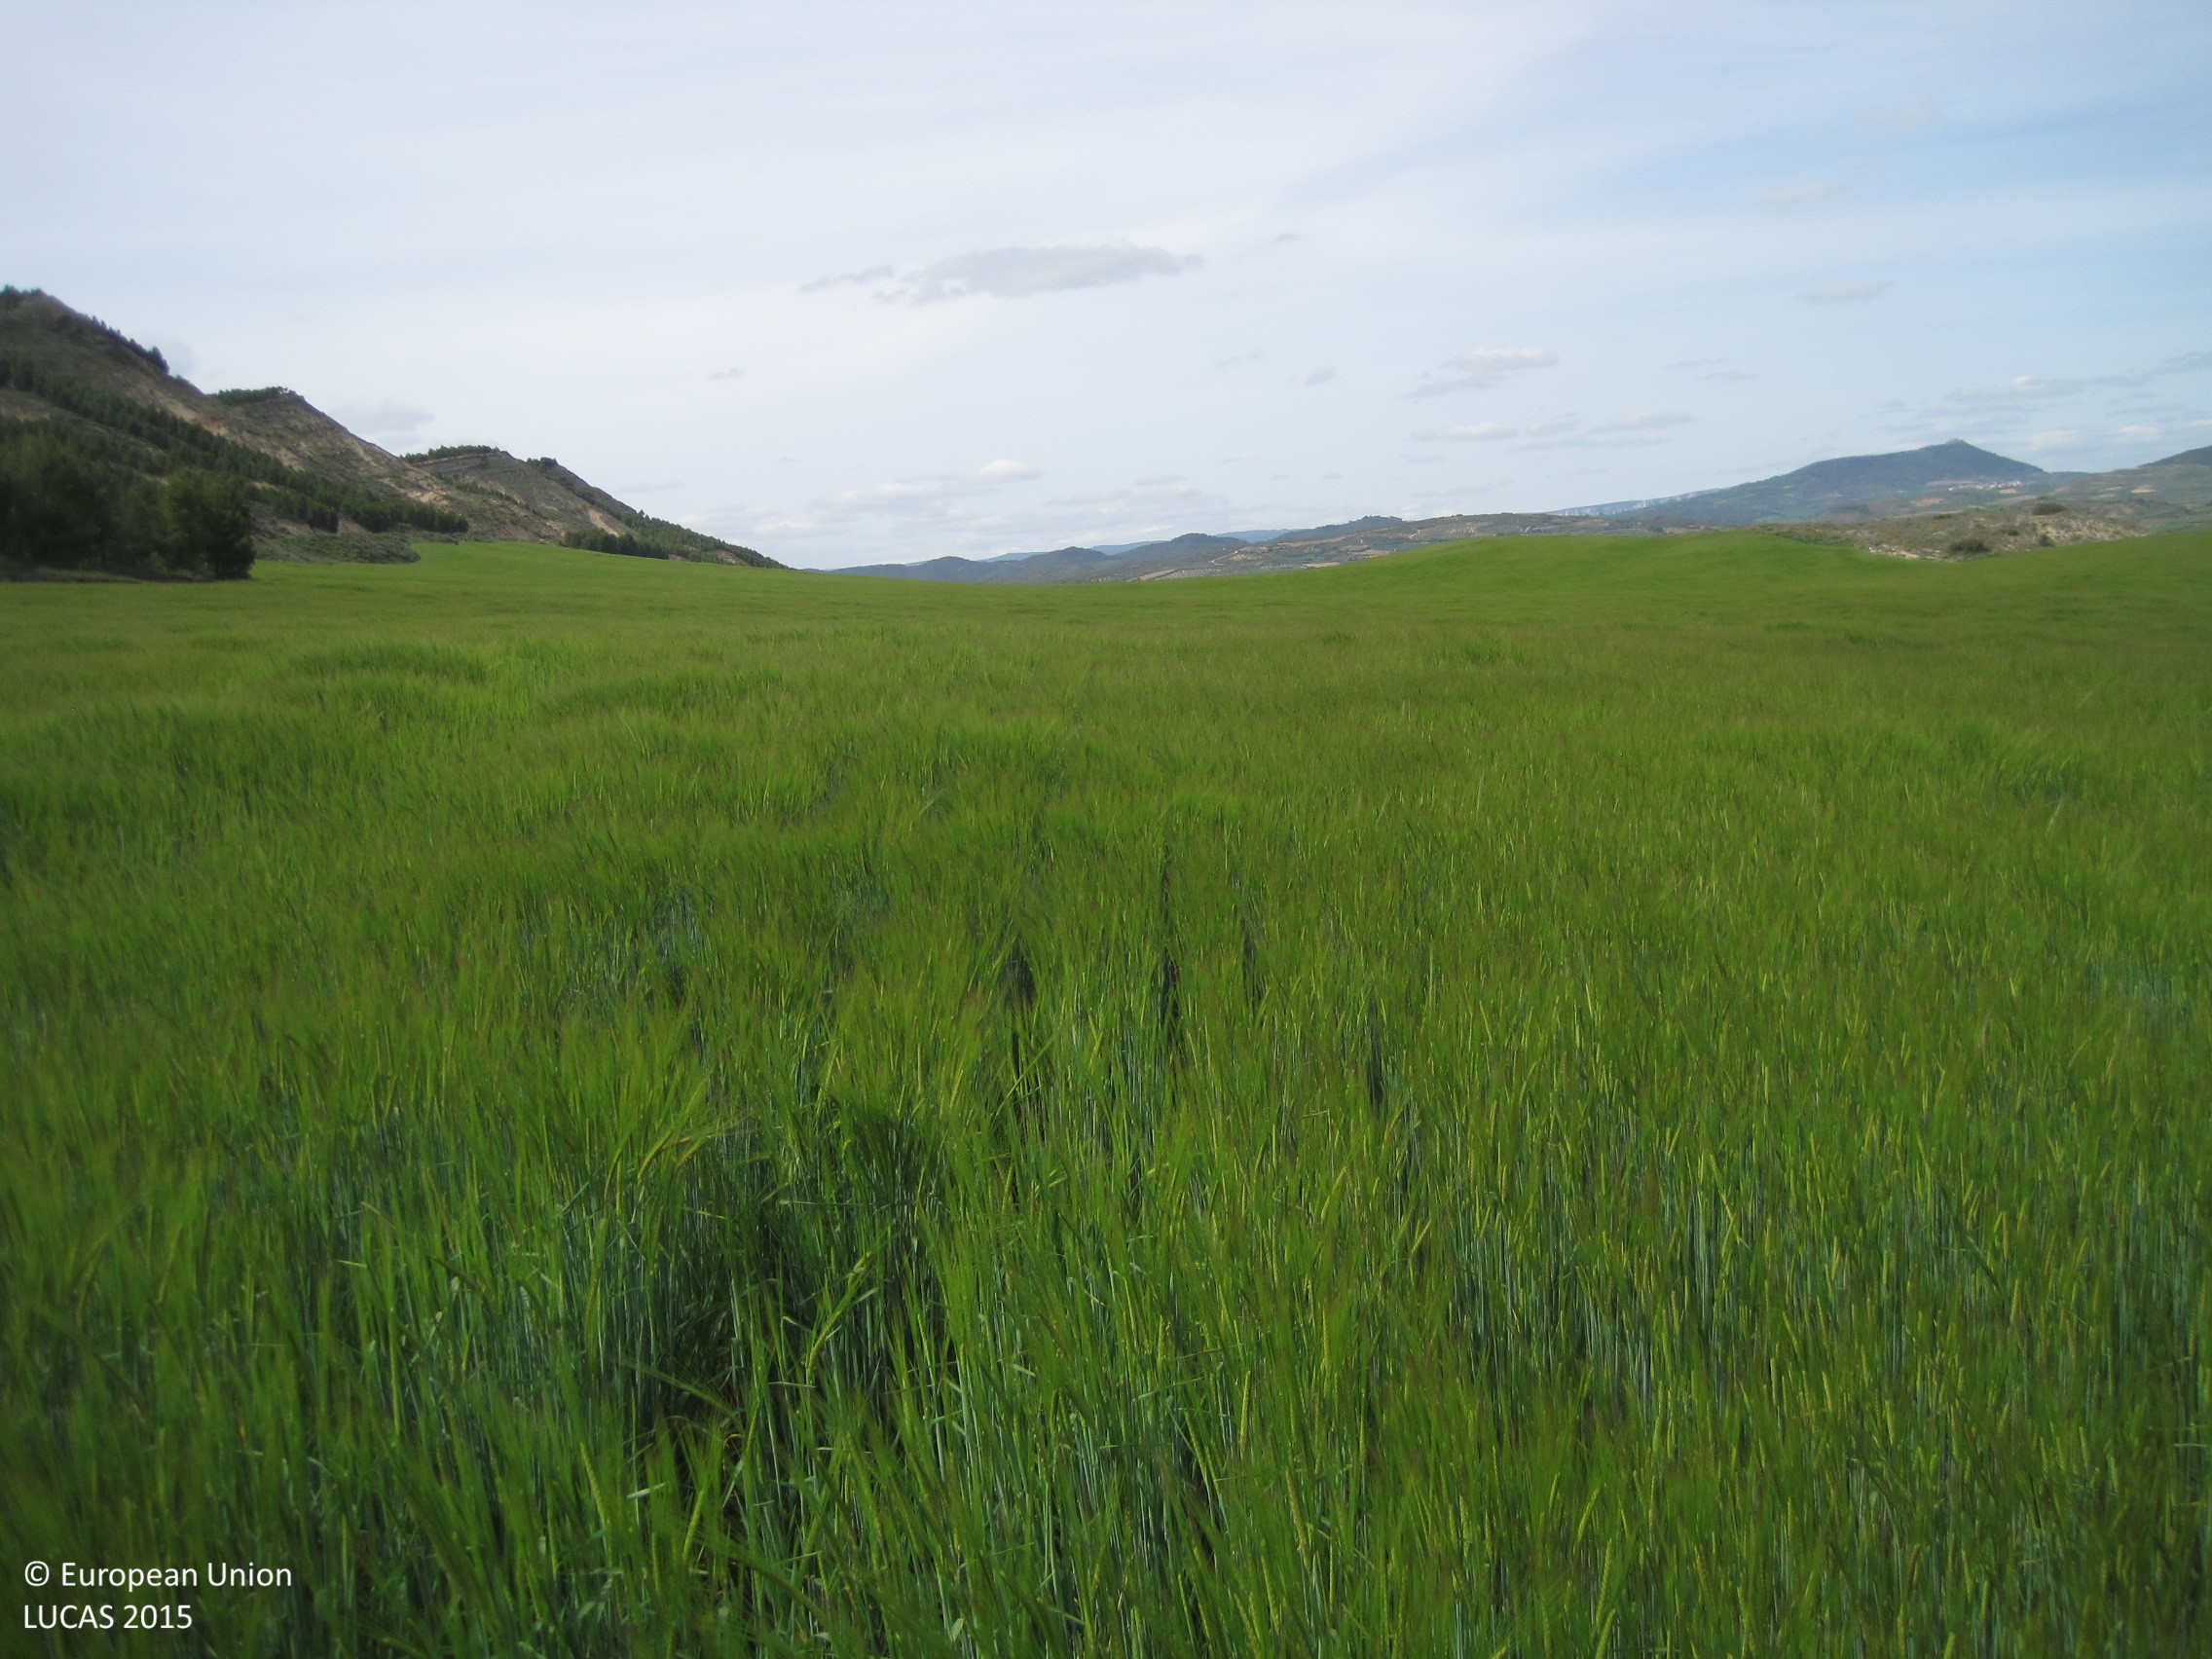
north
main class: Cropland
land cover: Barley
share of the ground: > 75 %
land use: Agriculture (excluding fallow land and kitchen gardens)
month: April
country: ES
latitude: 42.5448
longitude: -2.1093
